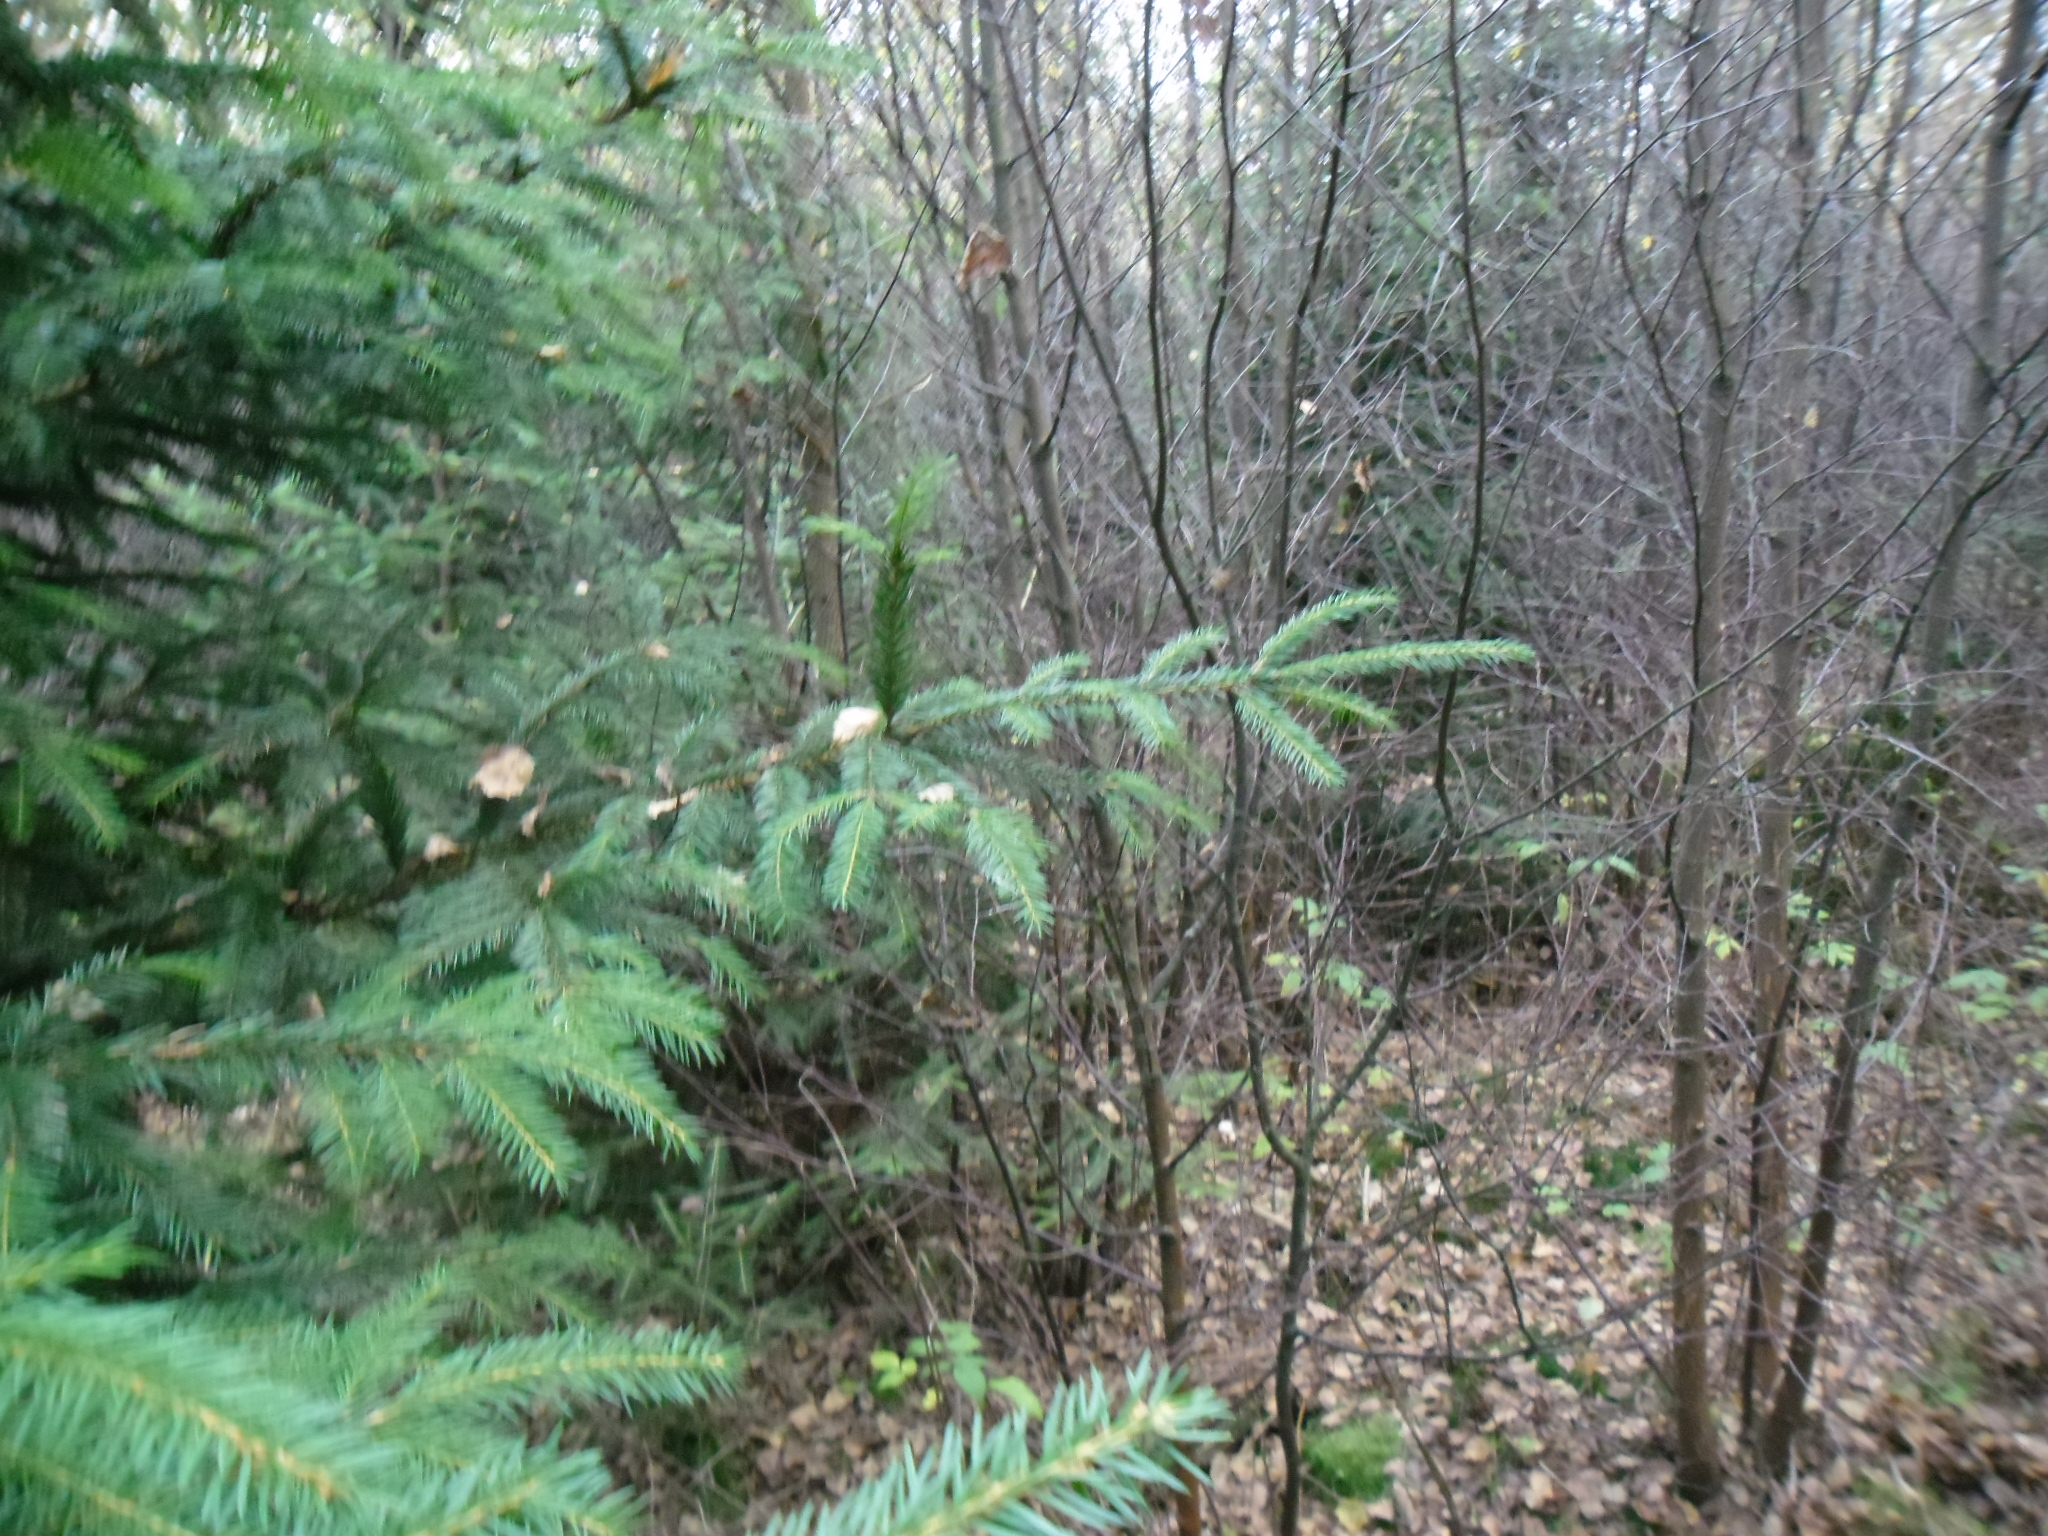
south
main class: Woodland
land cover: Spruce dominated mixed woodland
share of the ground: > 75 %
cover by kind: coniferous forest trees 65 %, broadleaved forest trees 35 %
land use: Forestry
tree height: < 5 m
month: October
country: SE
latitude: 56.6359
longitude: 13.1109
